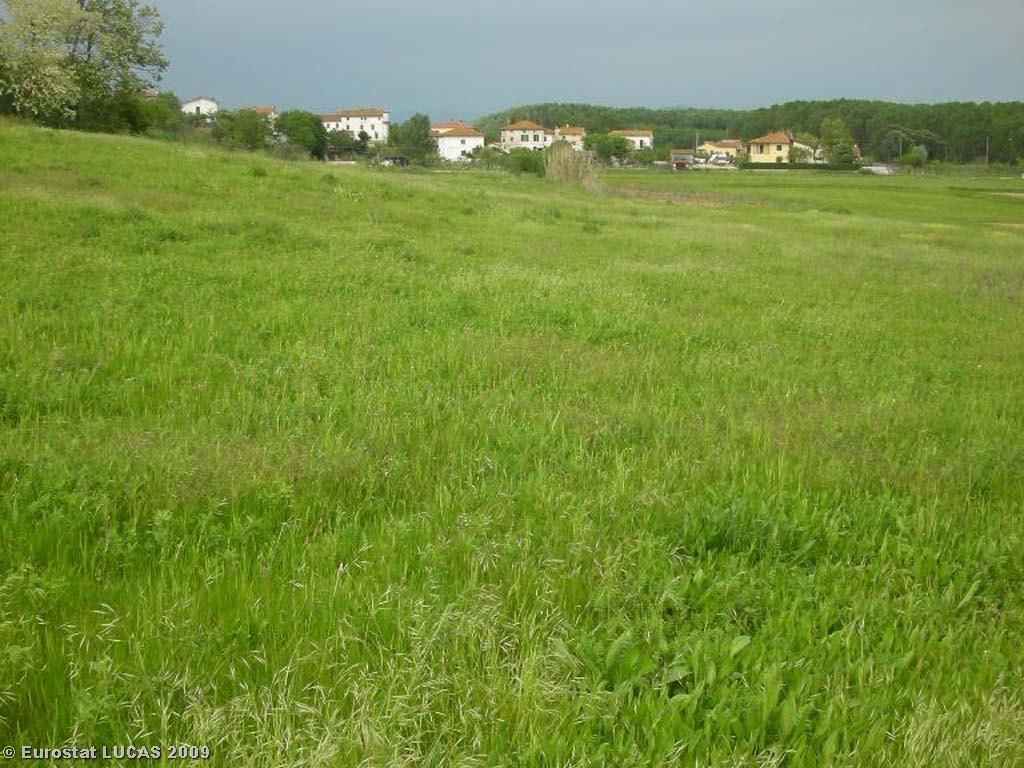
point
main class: Grassland
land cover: Grassland without tree/shrub cover
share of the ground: 50 - 75 %
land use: Agriculture (excluding fallow land and kitchen gardens)
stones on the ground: < 10 %
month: May
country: IT
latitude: 43.7701
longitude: 10.8054
